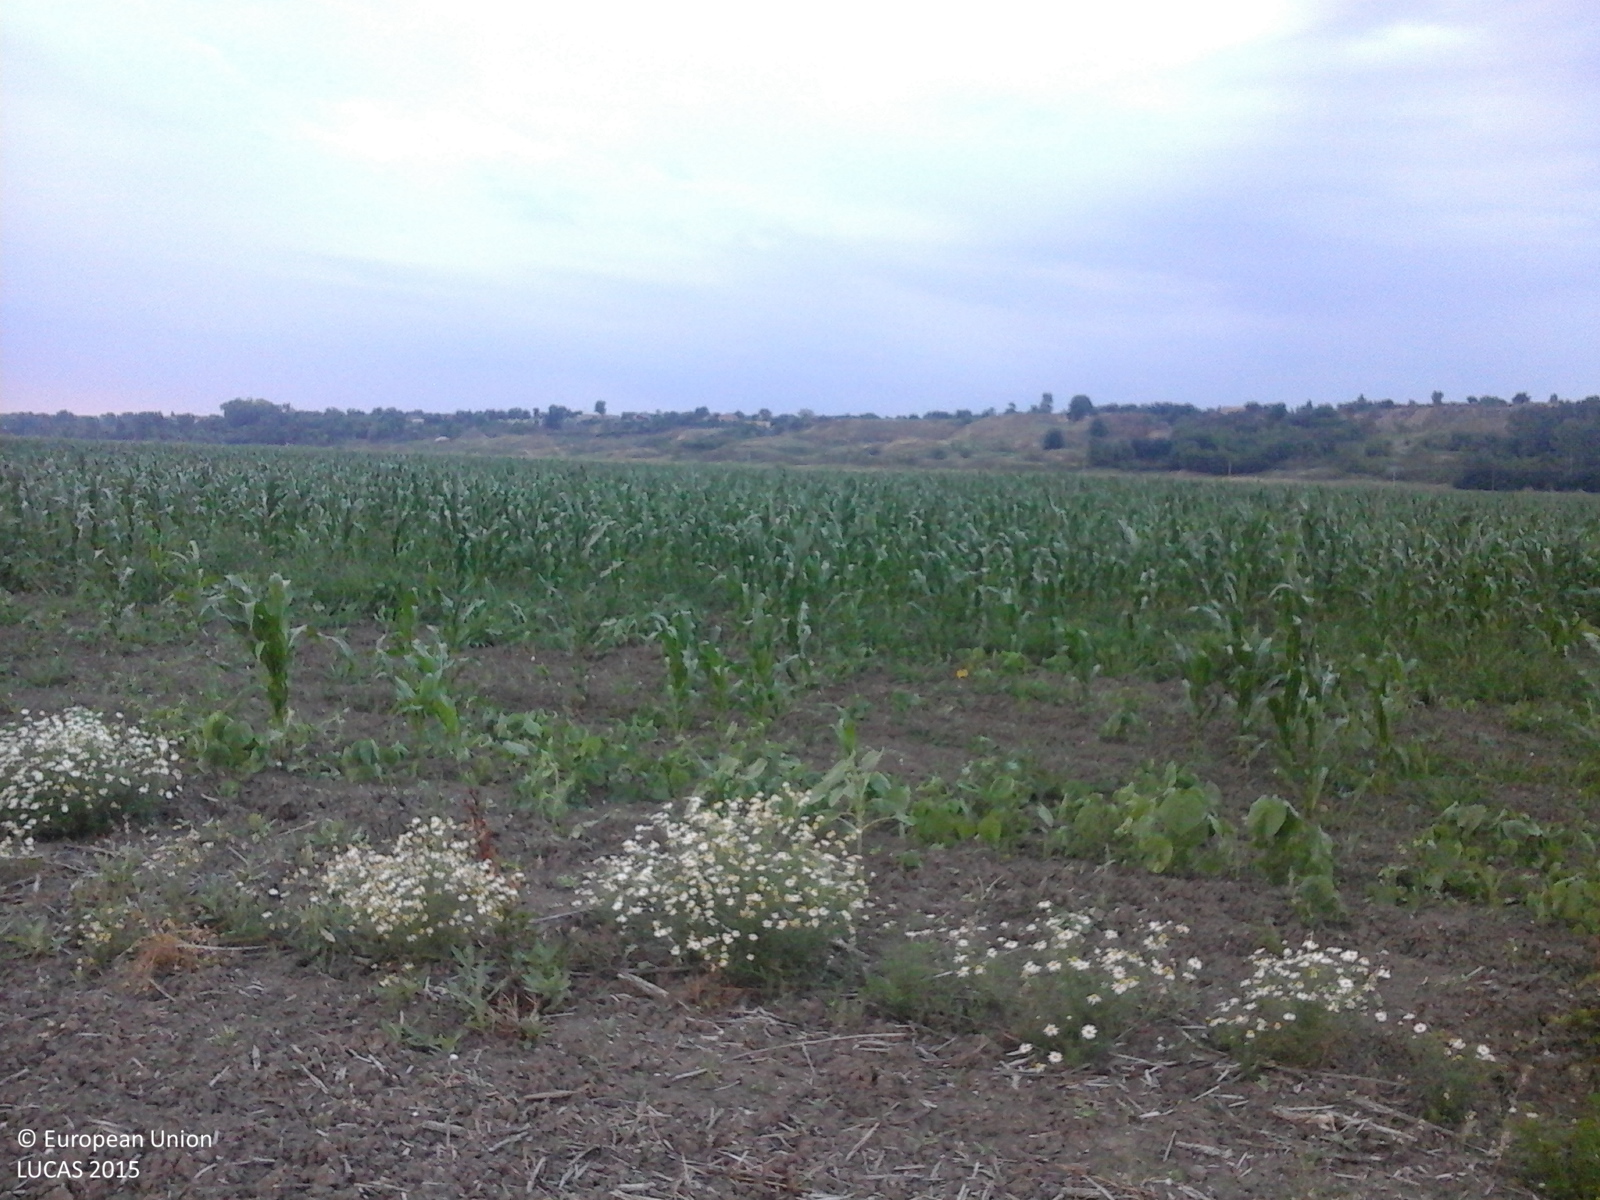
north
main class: Cropland
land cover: Maize
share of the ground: < 10 %
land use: Agriculture (excluding fallow land and kitchen gardens)
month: July
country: RO
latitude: 43.7518
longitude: 24.2042
